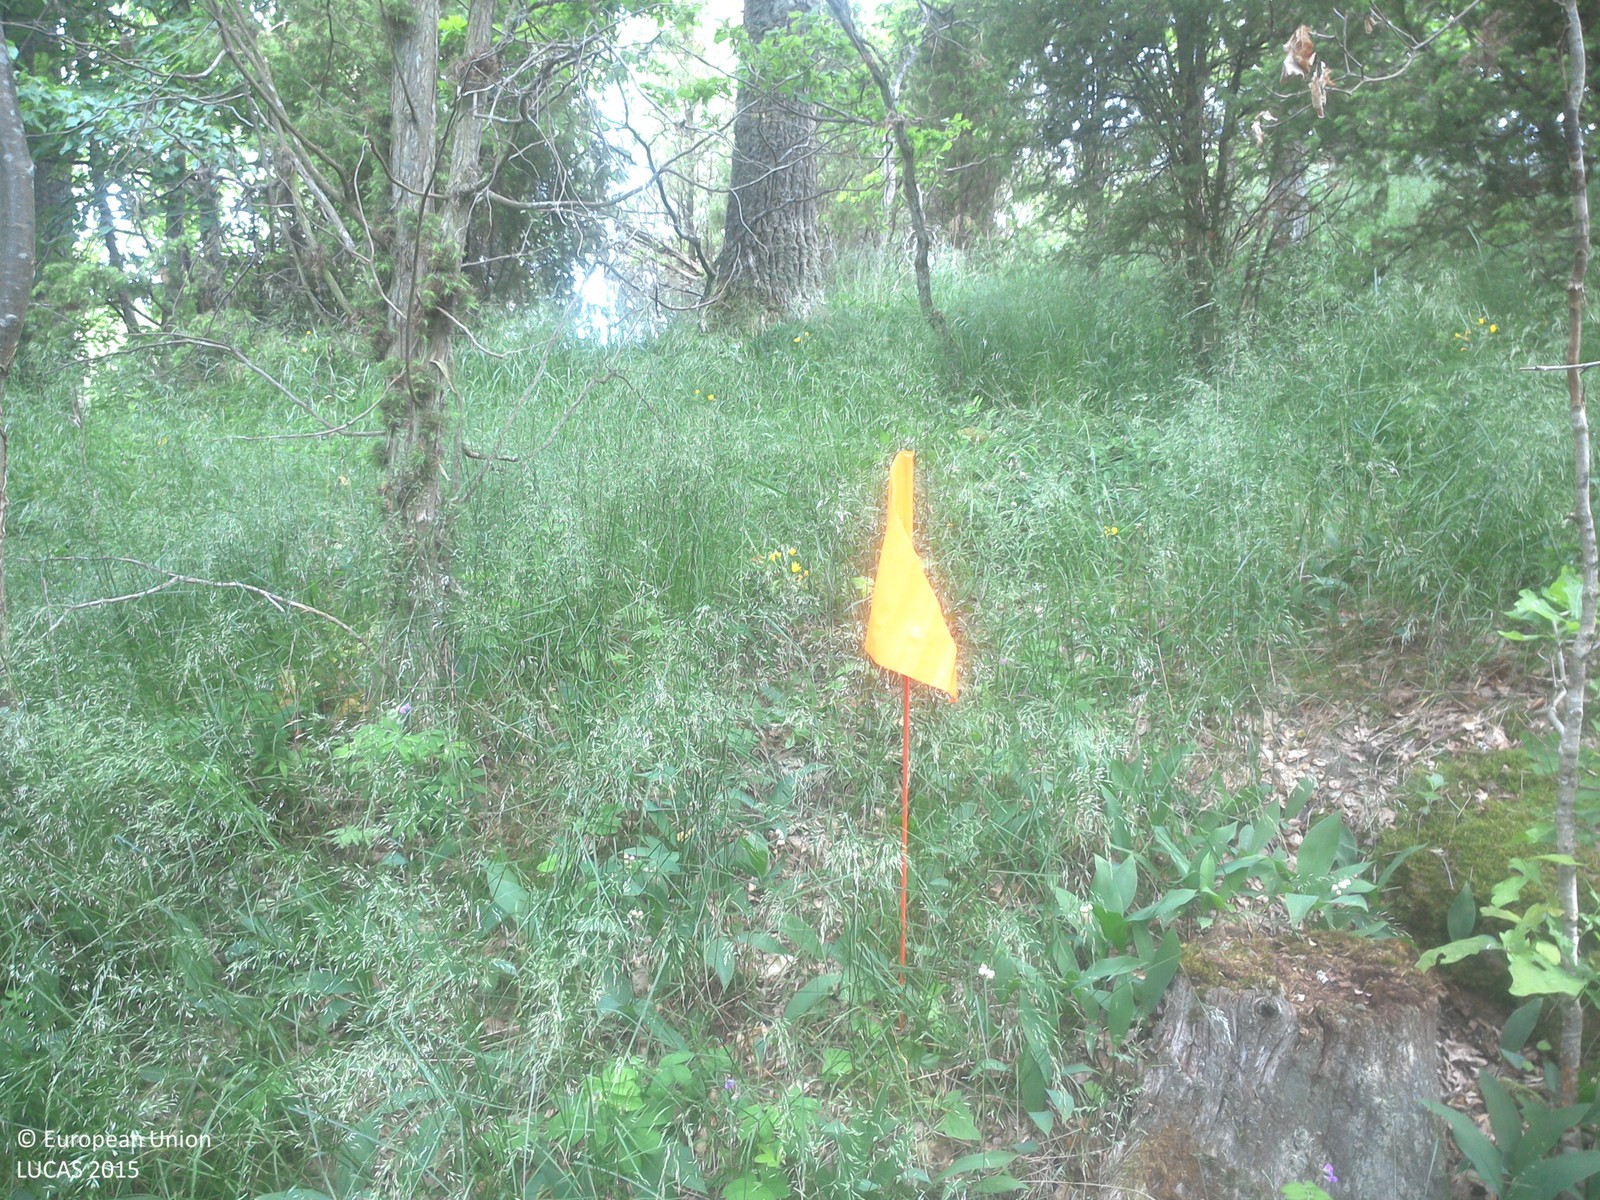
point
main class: Woodland
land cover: Broadleaved woodland
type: boreal forest
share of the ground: > 75 %
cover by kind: broadleaved forest trees 75 %, herbaceous plants 25 %
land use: Forestry
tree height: > 5 m
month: June
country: SE
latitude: 58.1519
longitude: 15.7215
